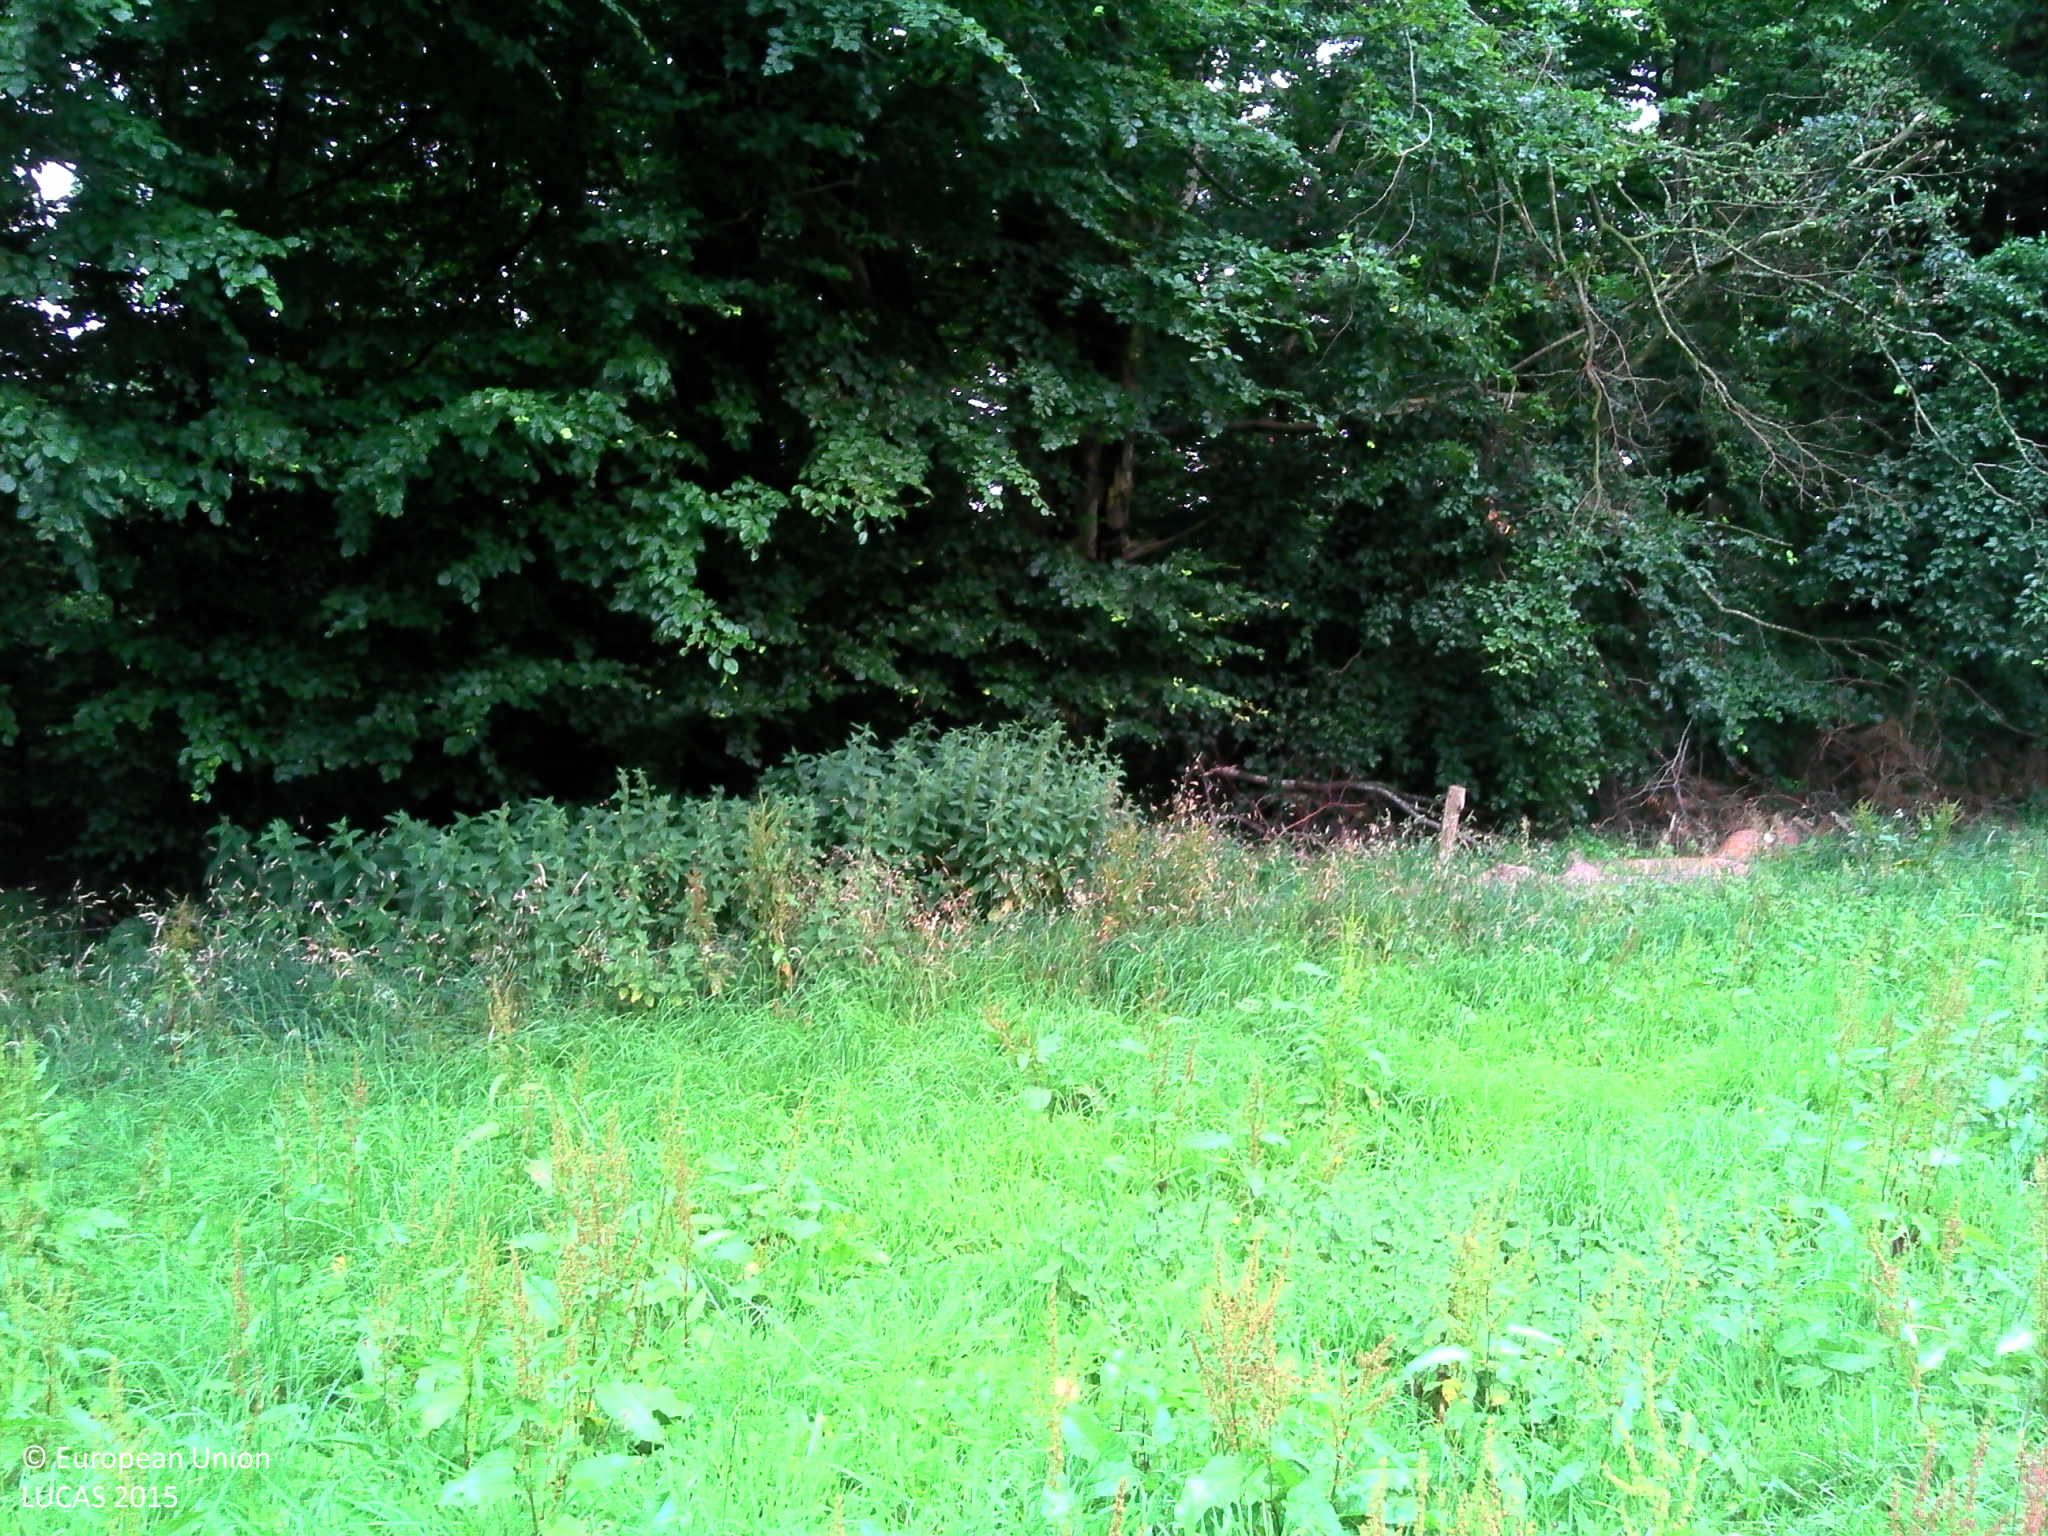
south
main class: Grassland
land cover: Grassland without tree/shrub cover
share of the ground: > 75 %
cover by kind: herbaceous plants 100 %
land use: Agriculture (excluding fallow land and kitchen gardens)
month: July
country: FR
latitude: 48.8914
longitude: -1.3254
